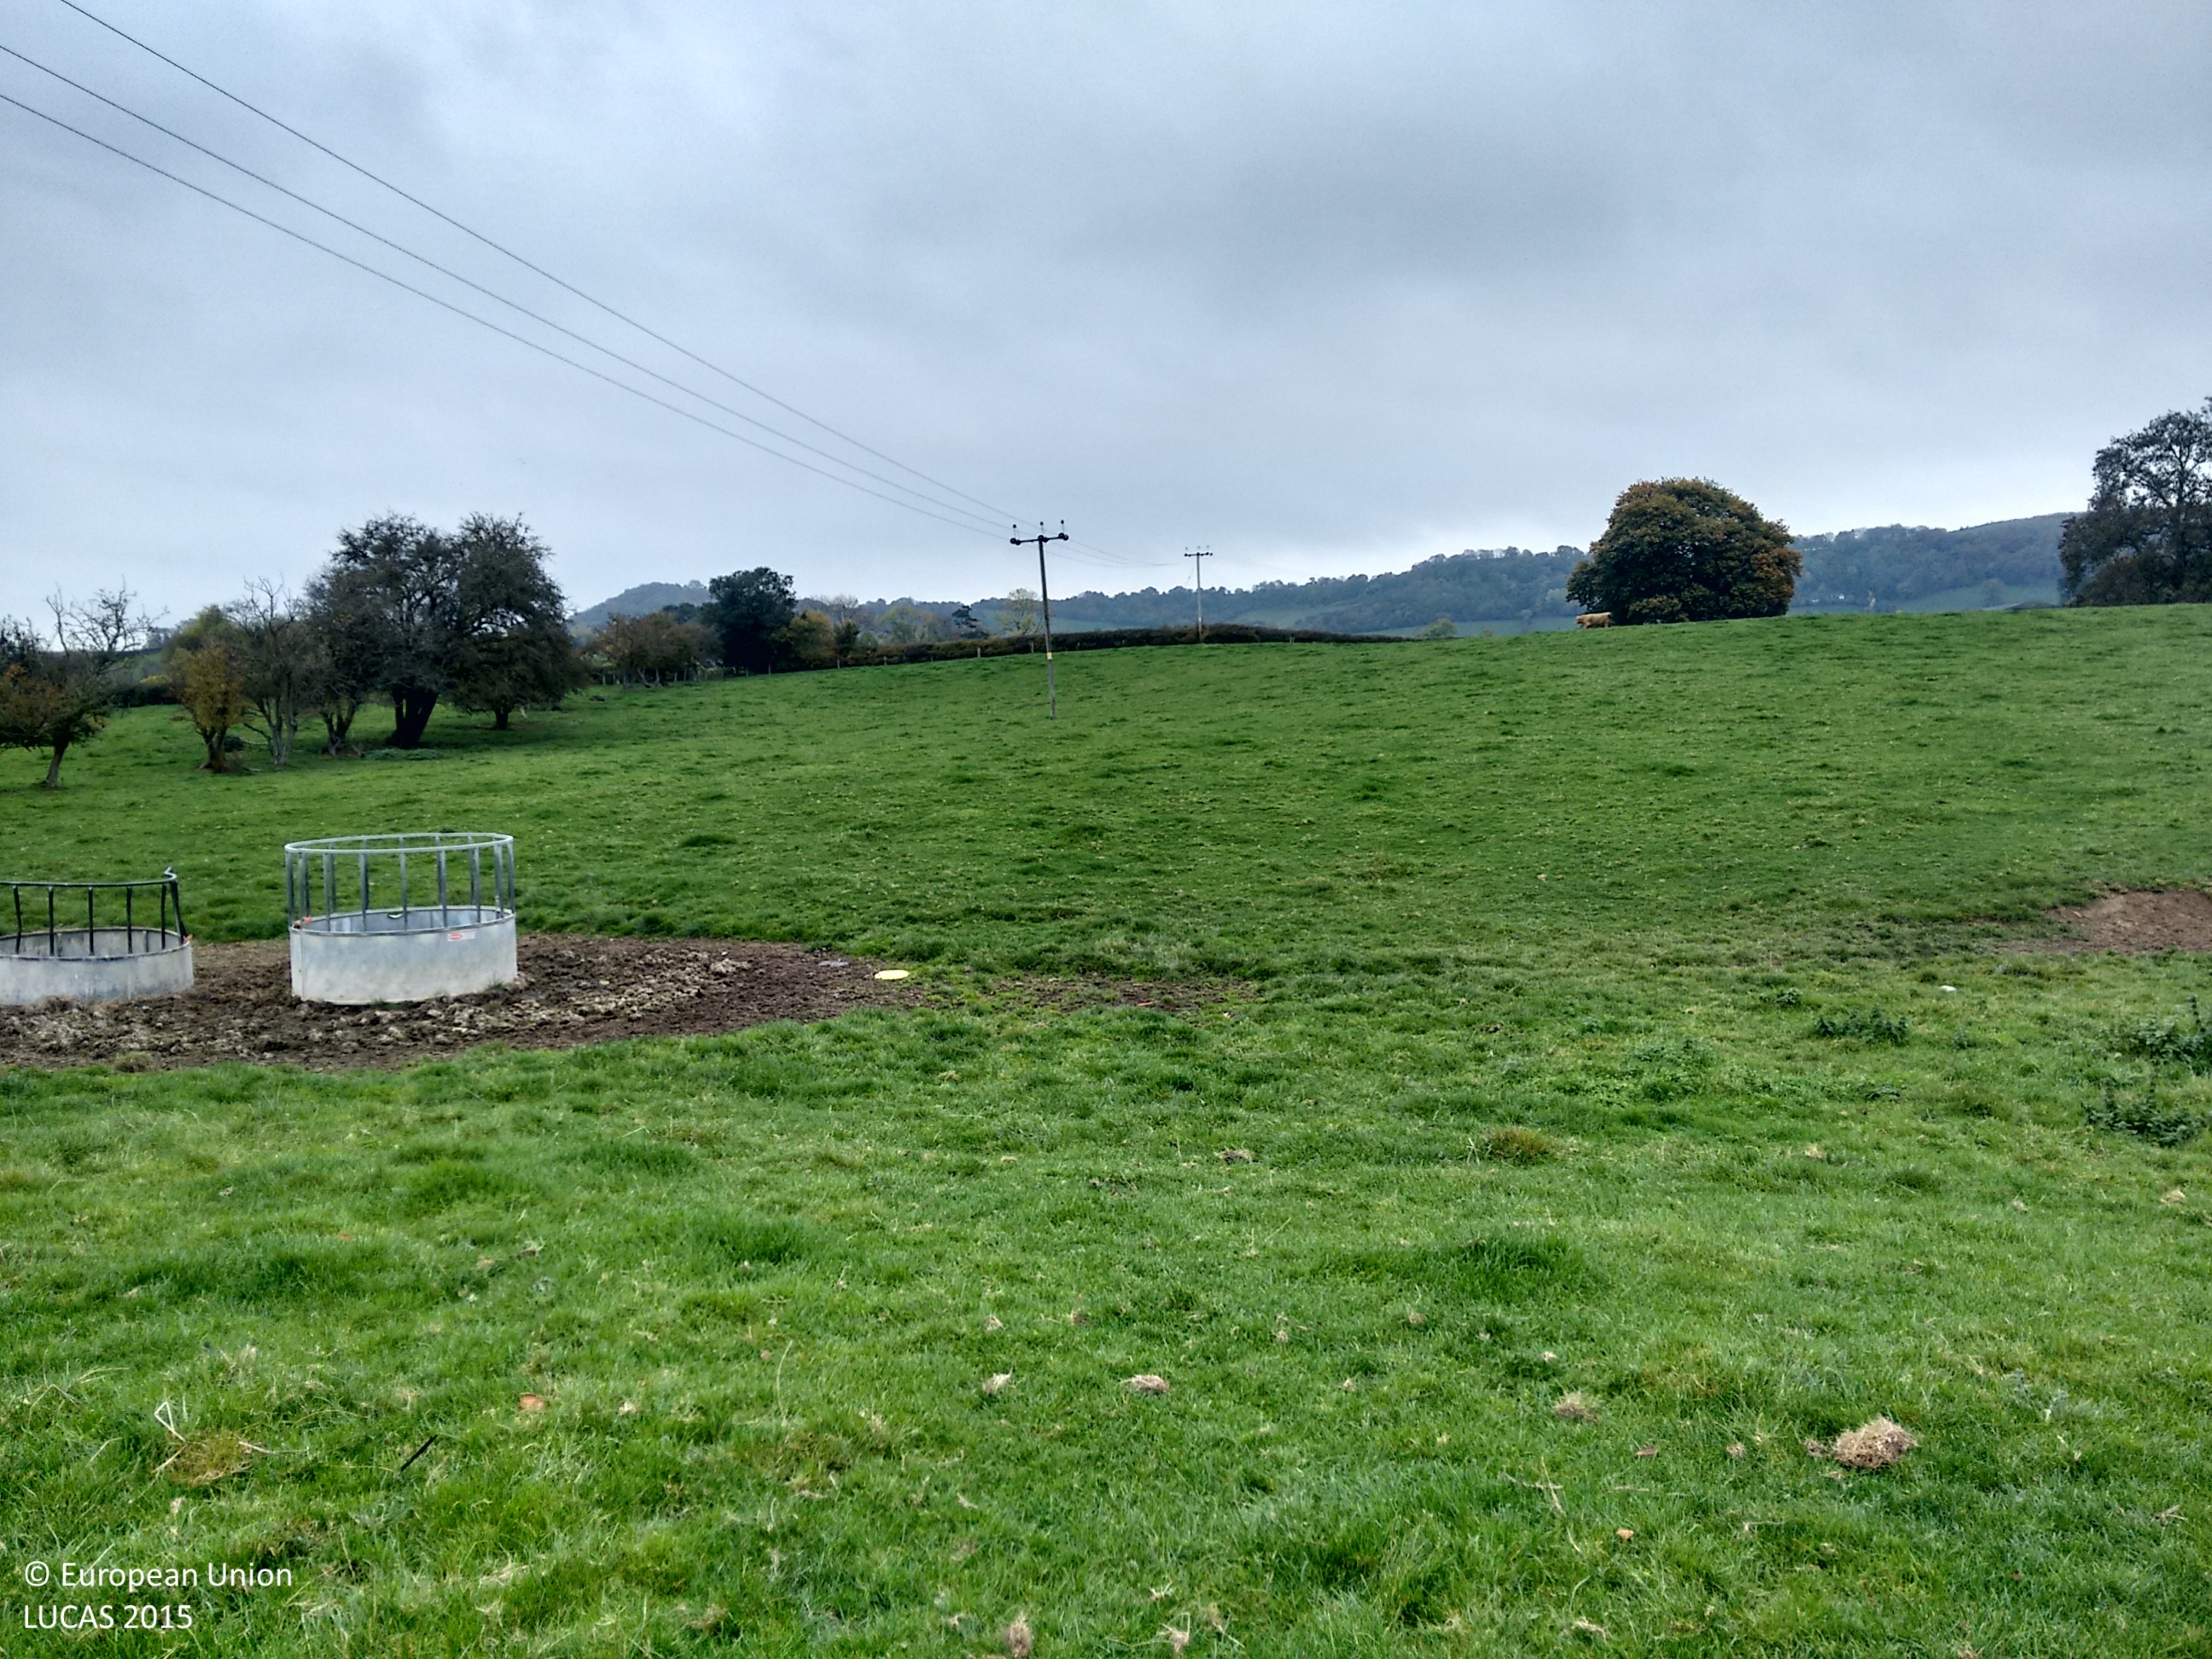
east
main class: Grassland
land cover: Grassland without tree/shrub cover
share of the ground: > 75 %
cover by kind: herbaceous plants 100 %
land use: Agriculture (excluding fallow land and kitchen gardens)
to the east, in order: Grassland without tree/shrub cover; Electric lines; Grassland without tree/shrub cover; Fences; Managed hedges; Fences; Grassland without tree/shrub cover
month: October
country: GB
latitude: 52.4189
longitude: -2.8798
